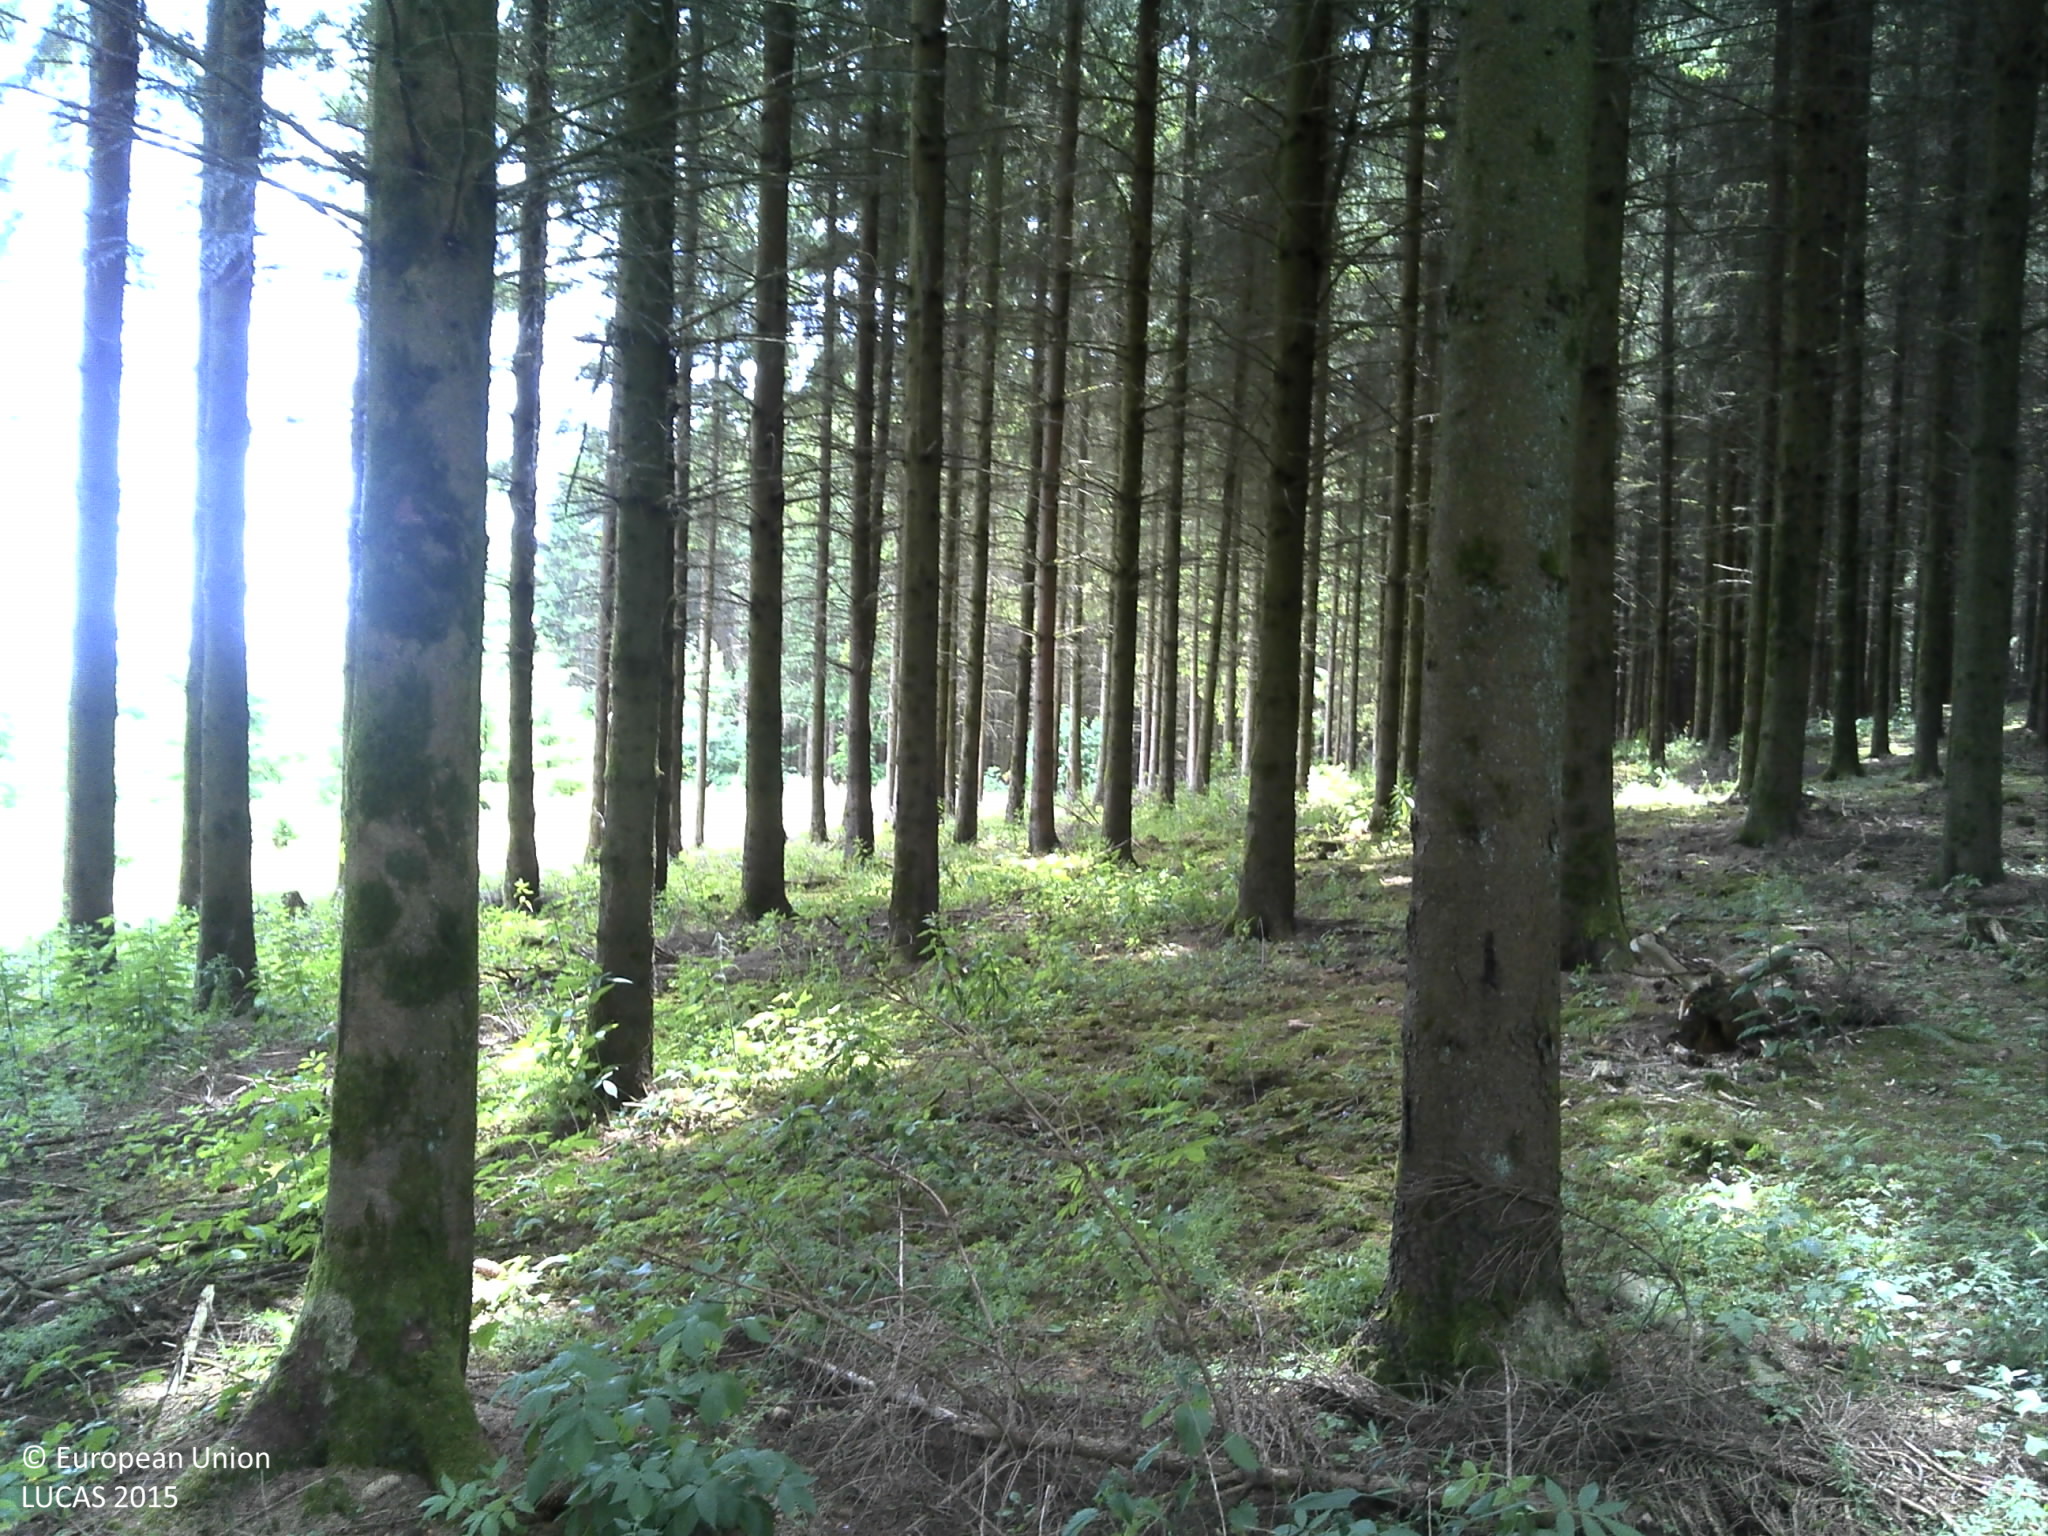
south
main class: Woodland
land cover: Spruce dominated coniferous woodland
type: exotic forest
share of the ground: > 75 %
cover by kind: coniferous forest trees 75 %, herbaceous plants 10 %, lichens and mosses 10 %, consolidated bare surface 5 %
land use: Forestry
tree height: > 5 m
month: June
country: LU
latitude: 50.0039
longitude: 5.9389
